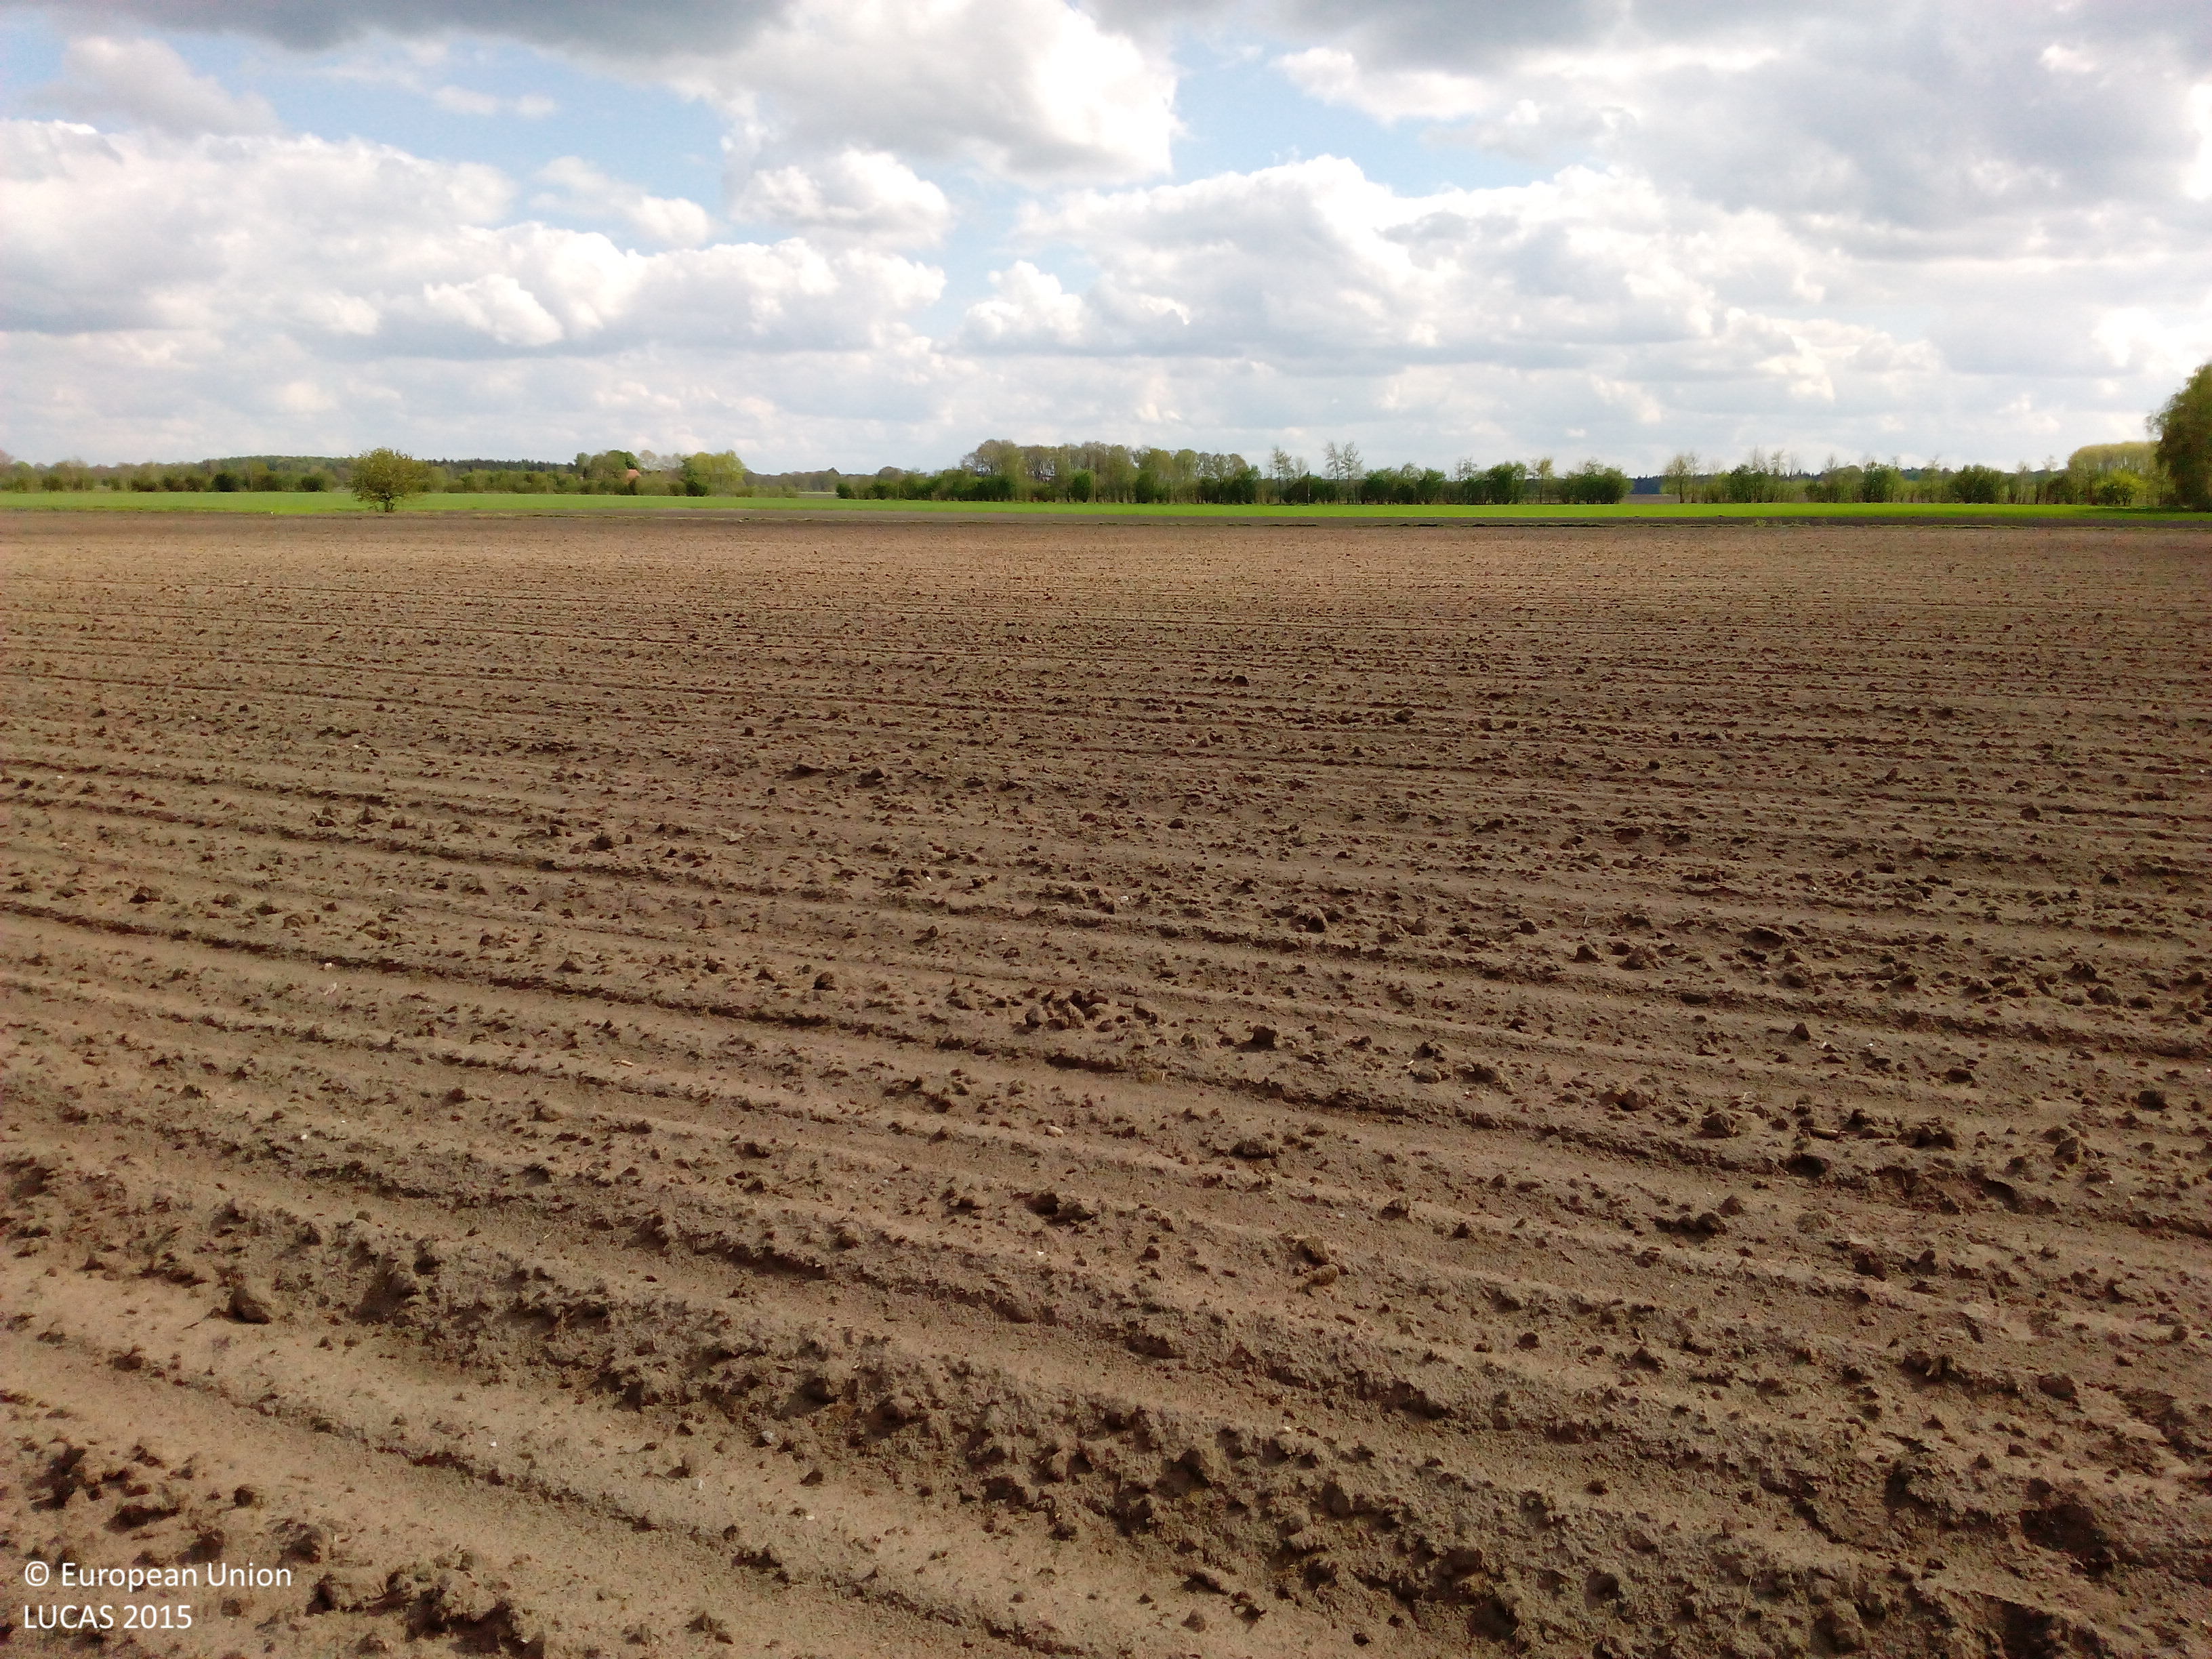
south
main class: Cropland
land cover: Sugar beet
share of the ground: < 10 %
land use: Agriculture (excluding fallow land and kitchen gardens)
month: May
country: DE
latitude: 52.9179
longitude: 7.9928
